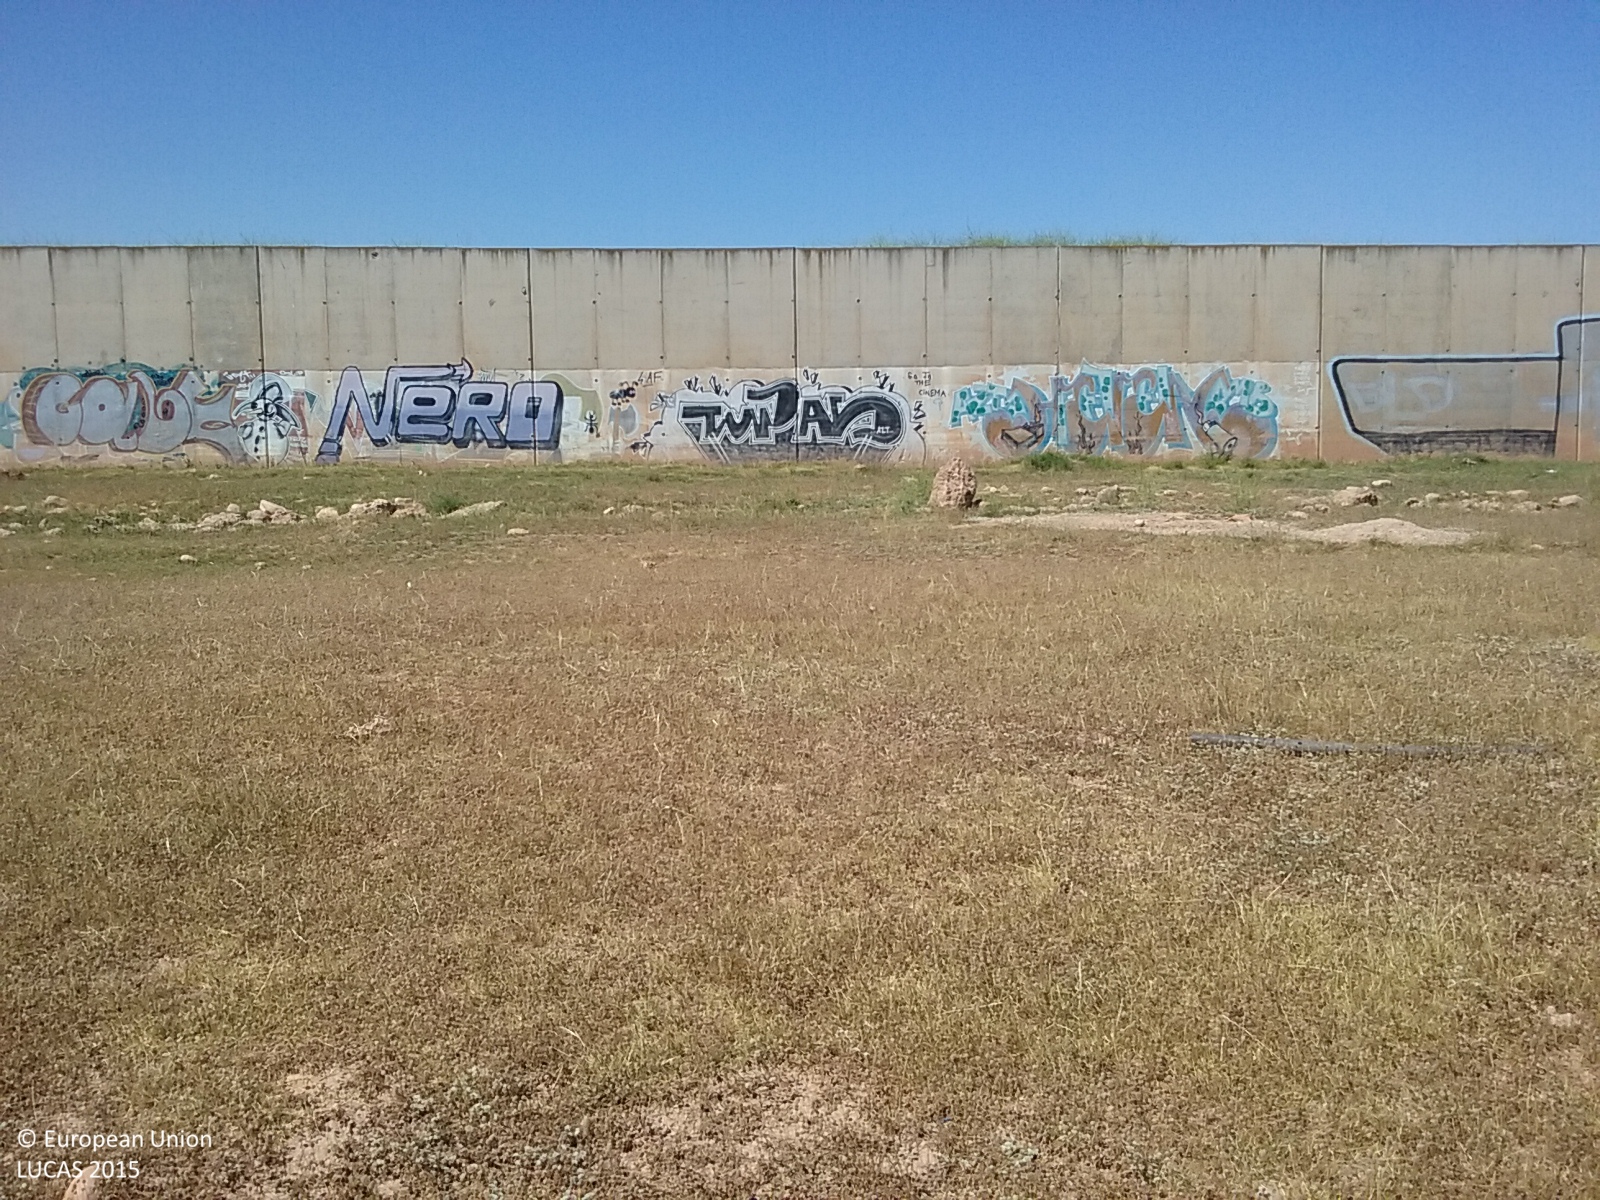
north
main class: Grassland
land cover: Grassland without tree/shrub cover
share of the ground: > 75 %
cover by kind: herbaceous plants 95 %, unconsolidated bare surface 5 %
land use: Semi-natural and natural areas not in use
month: May
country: ES
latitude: 39.9068
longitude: -0.1188
